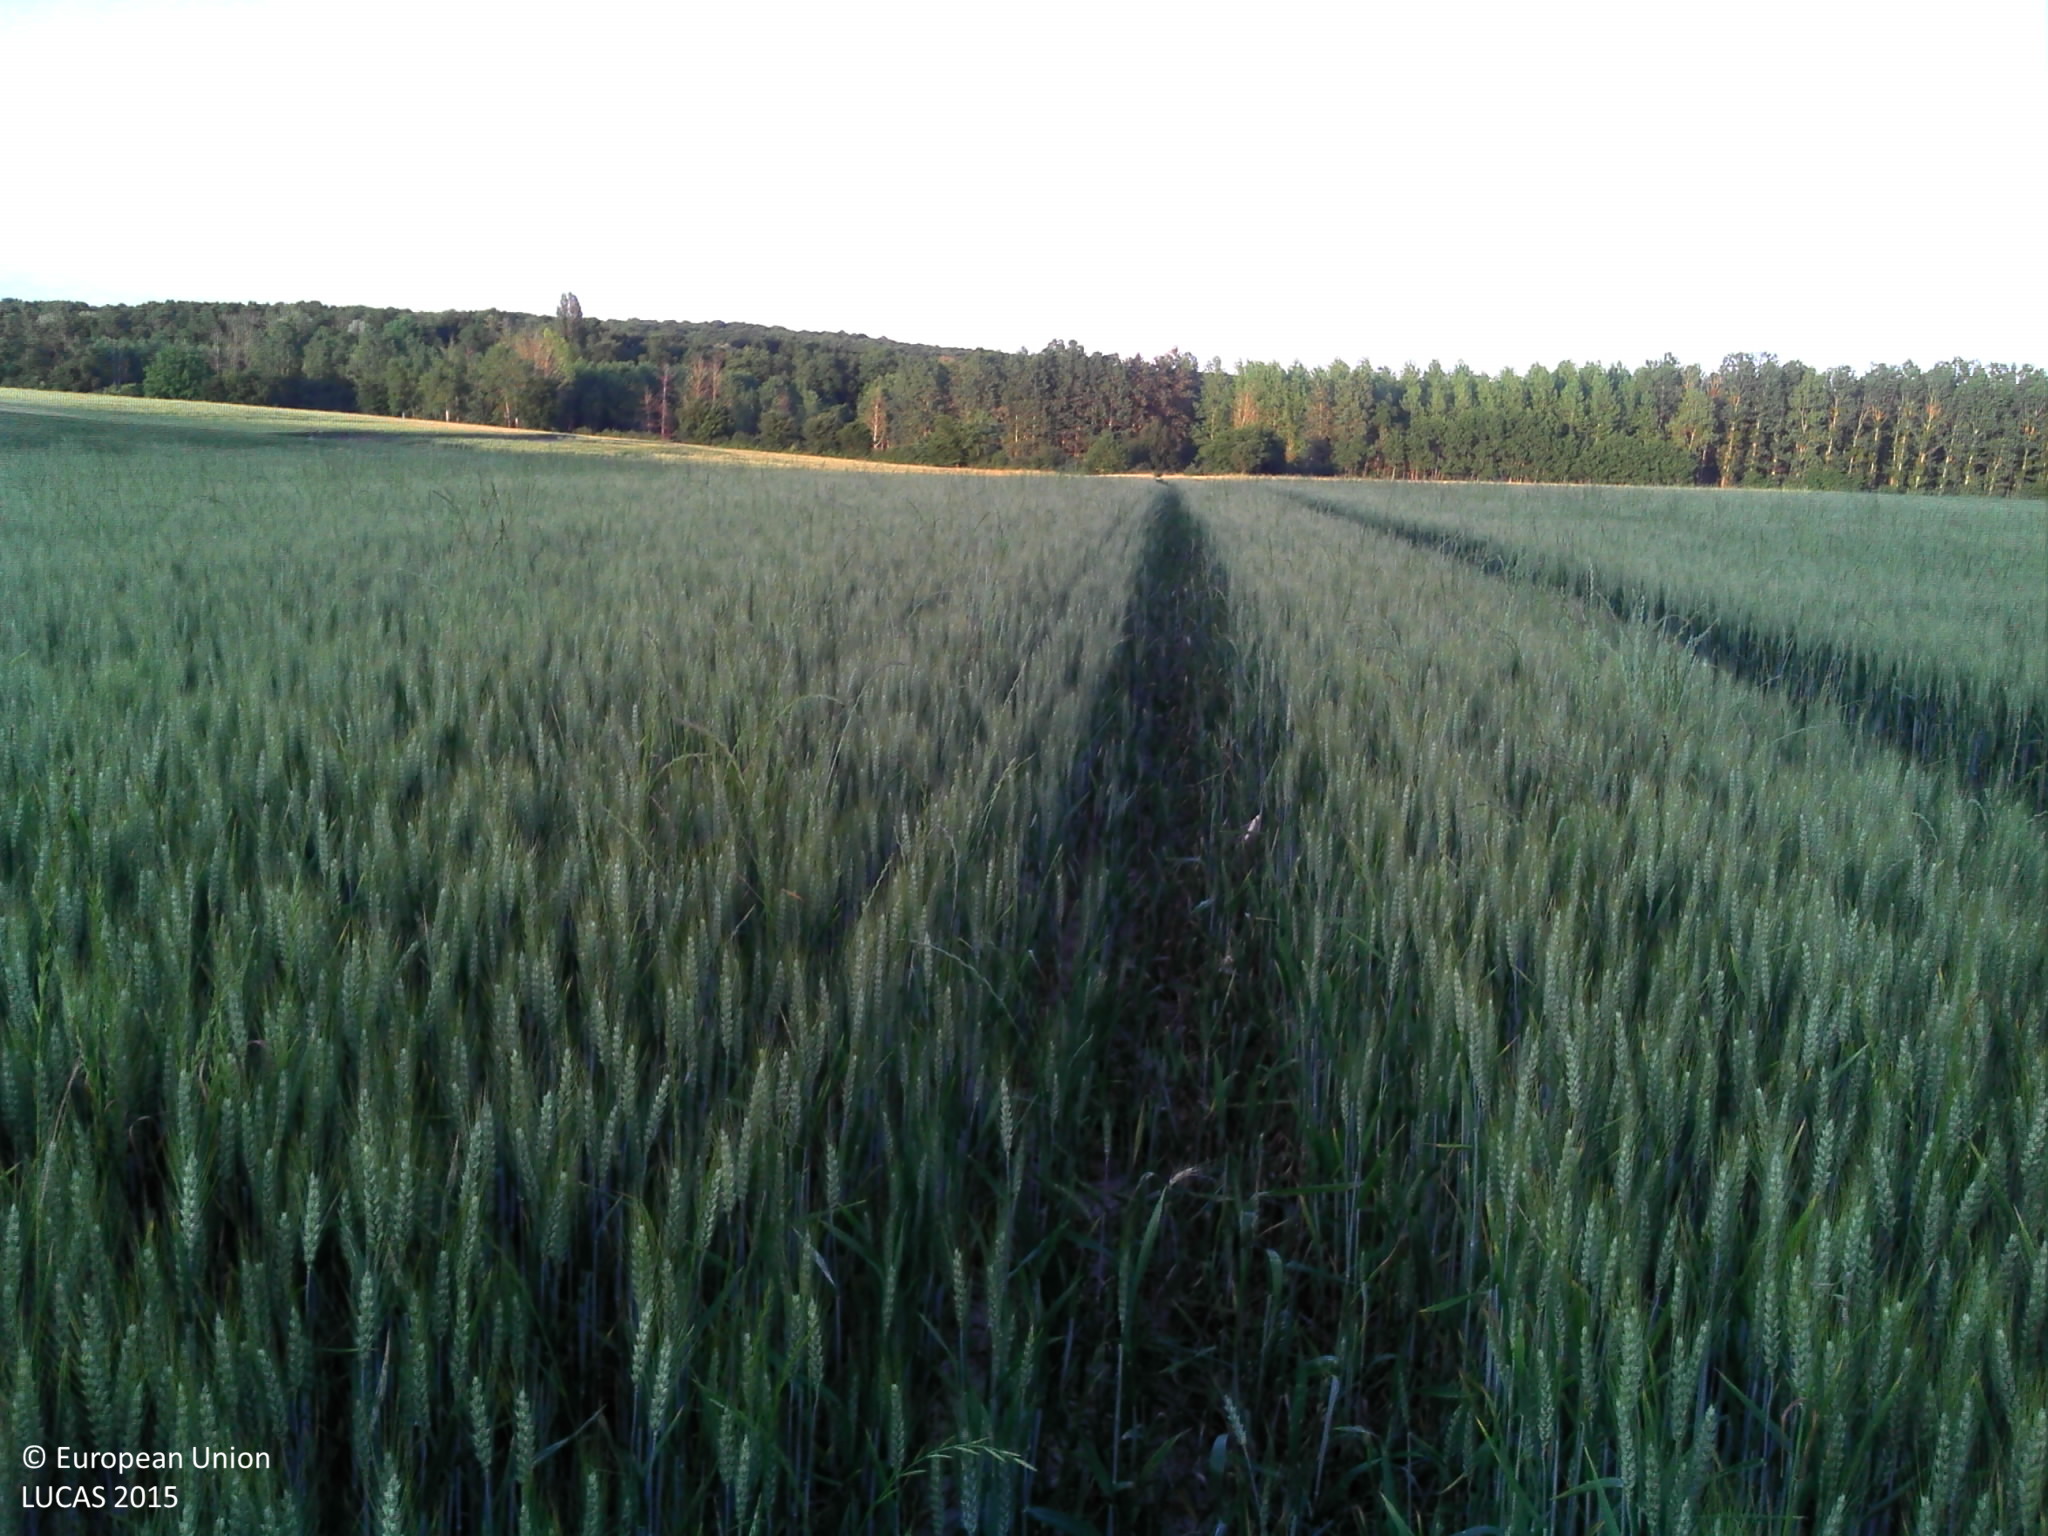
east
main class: Cropland
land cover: Common wheat
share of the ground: > 75 %
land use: Agriculture (excluding fallow land and kitchen gardens)
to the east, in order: Common wheat
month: June
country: FR
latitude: 46.8580
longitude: 2.9260
